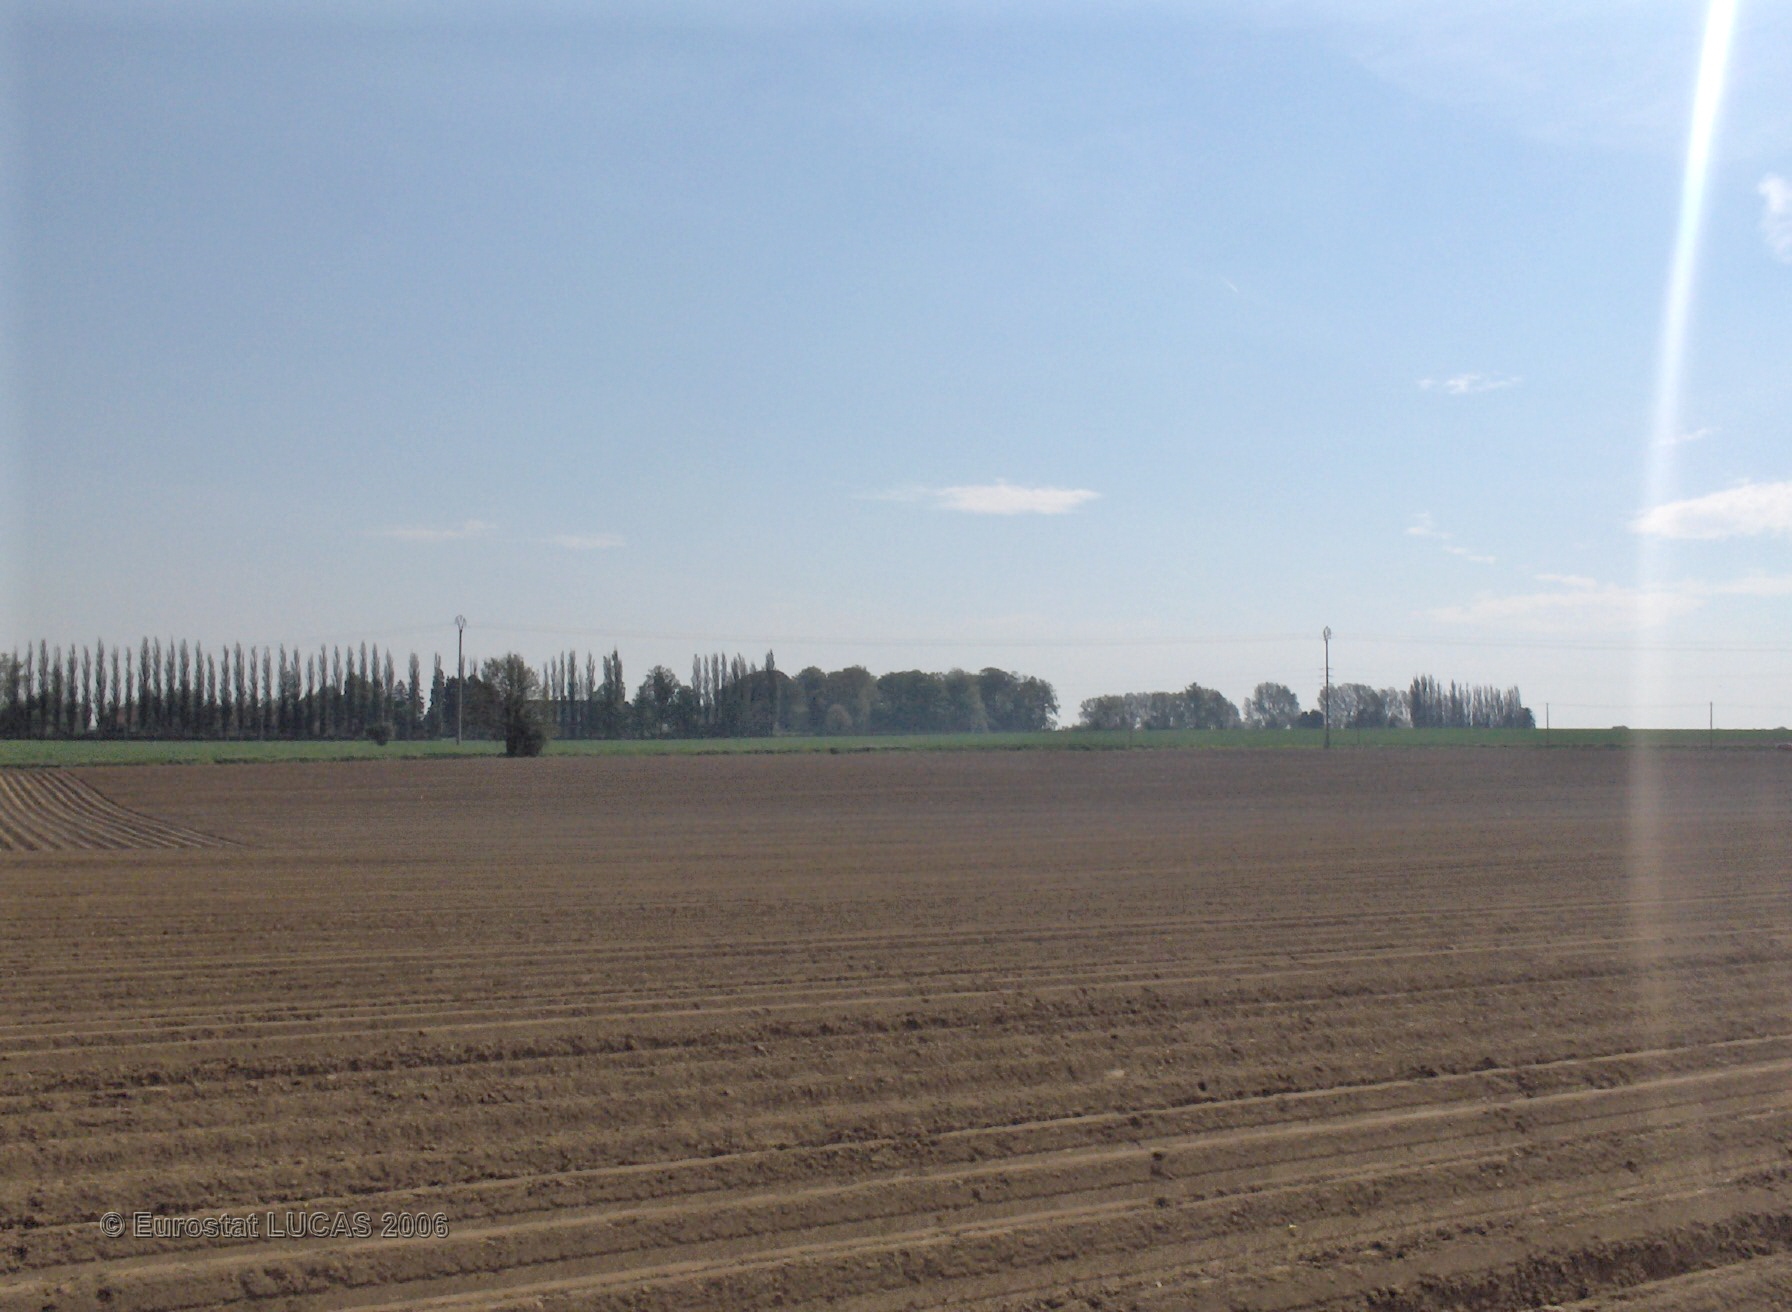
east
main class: Cropland
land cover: Potatoes
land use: Agriculture (excluding fallow land and kitchen gardens)
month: May
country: BE
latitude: 50.6609
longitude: 5.2302
